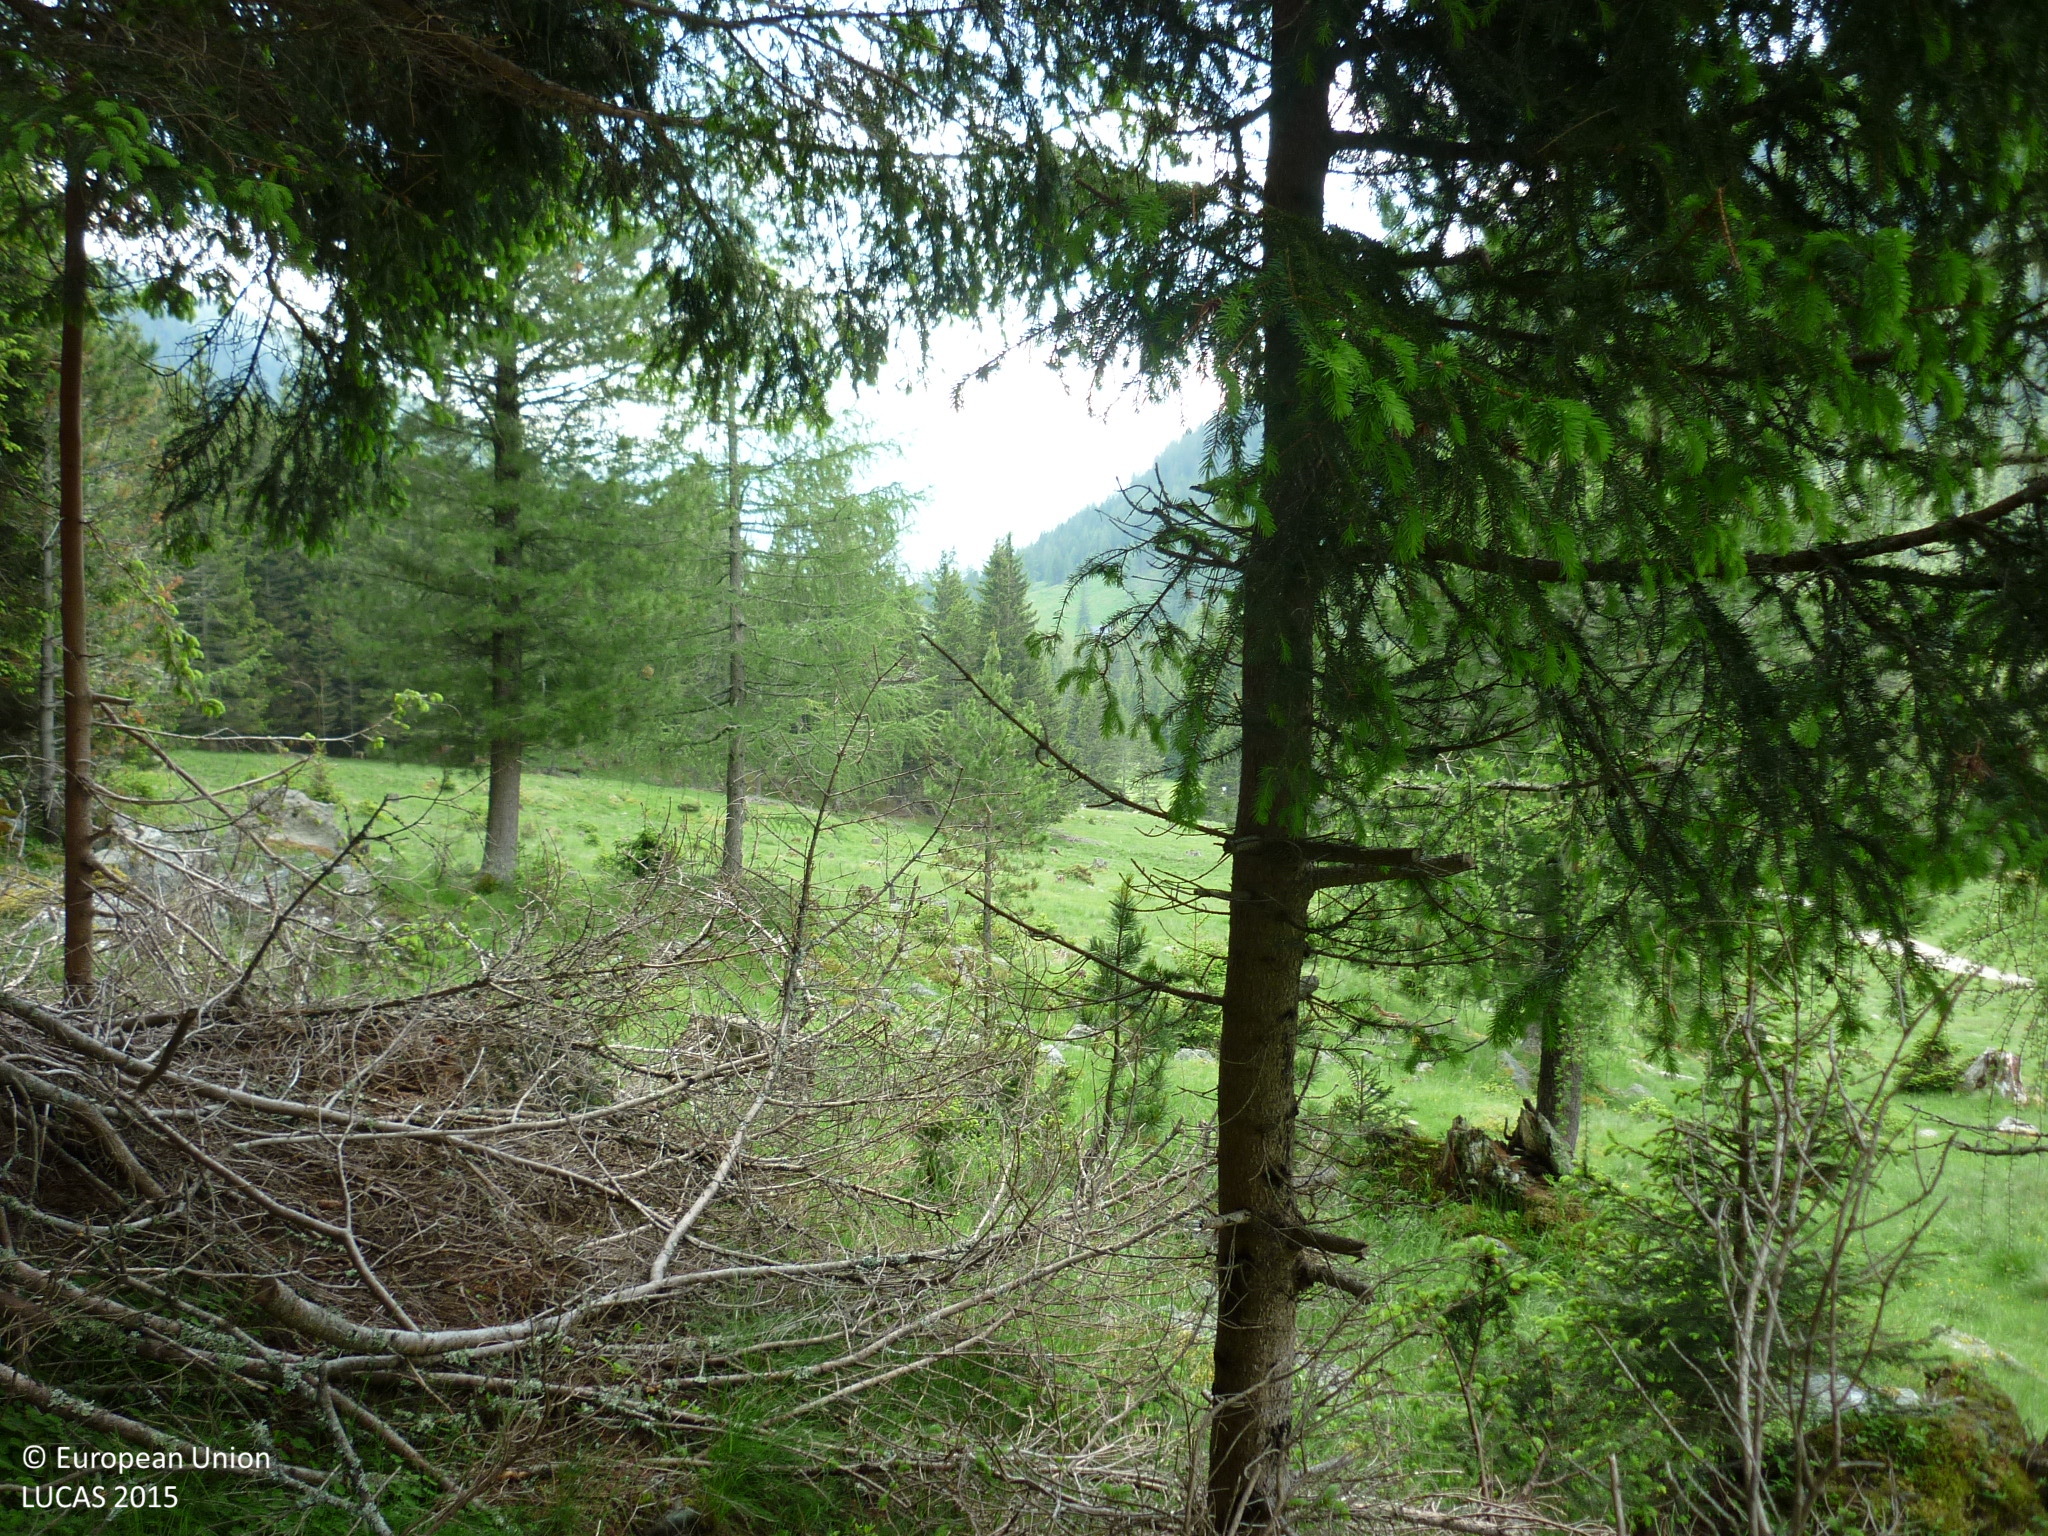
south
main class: Woodland
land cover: Spruce dominated coniferous woodland
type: alpine coniferous forest
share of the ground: > 75 %
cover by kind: coniferous forest trees 90 %, herbaceous plants 5 %, lichens and mosses 5 %
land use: Forestry
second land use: Amenities, museums, leisure
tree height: > 5 m
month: June
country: AT
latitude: 47.2329
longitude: 13.9740
